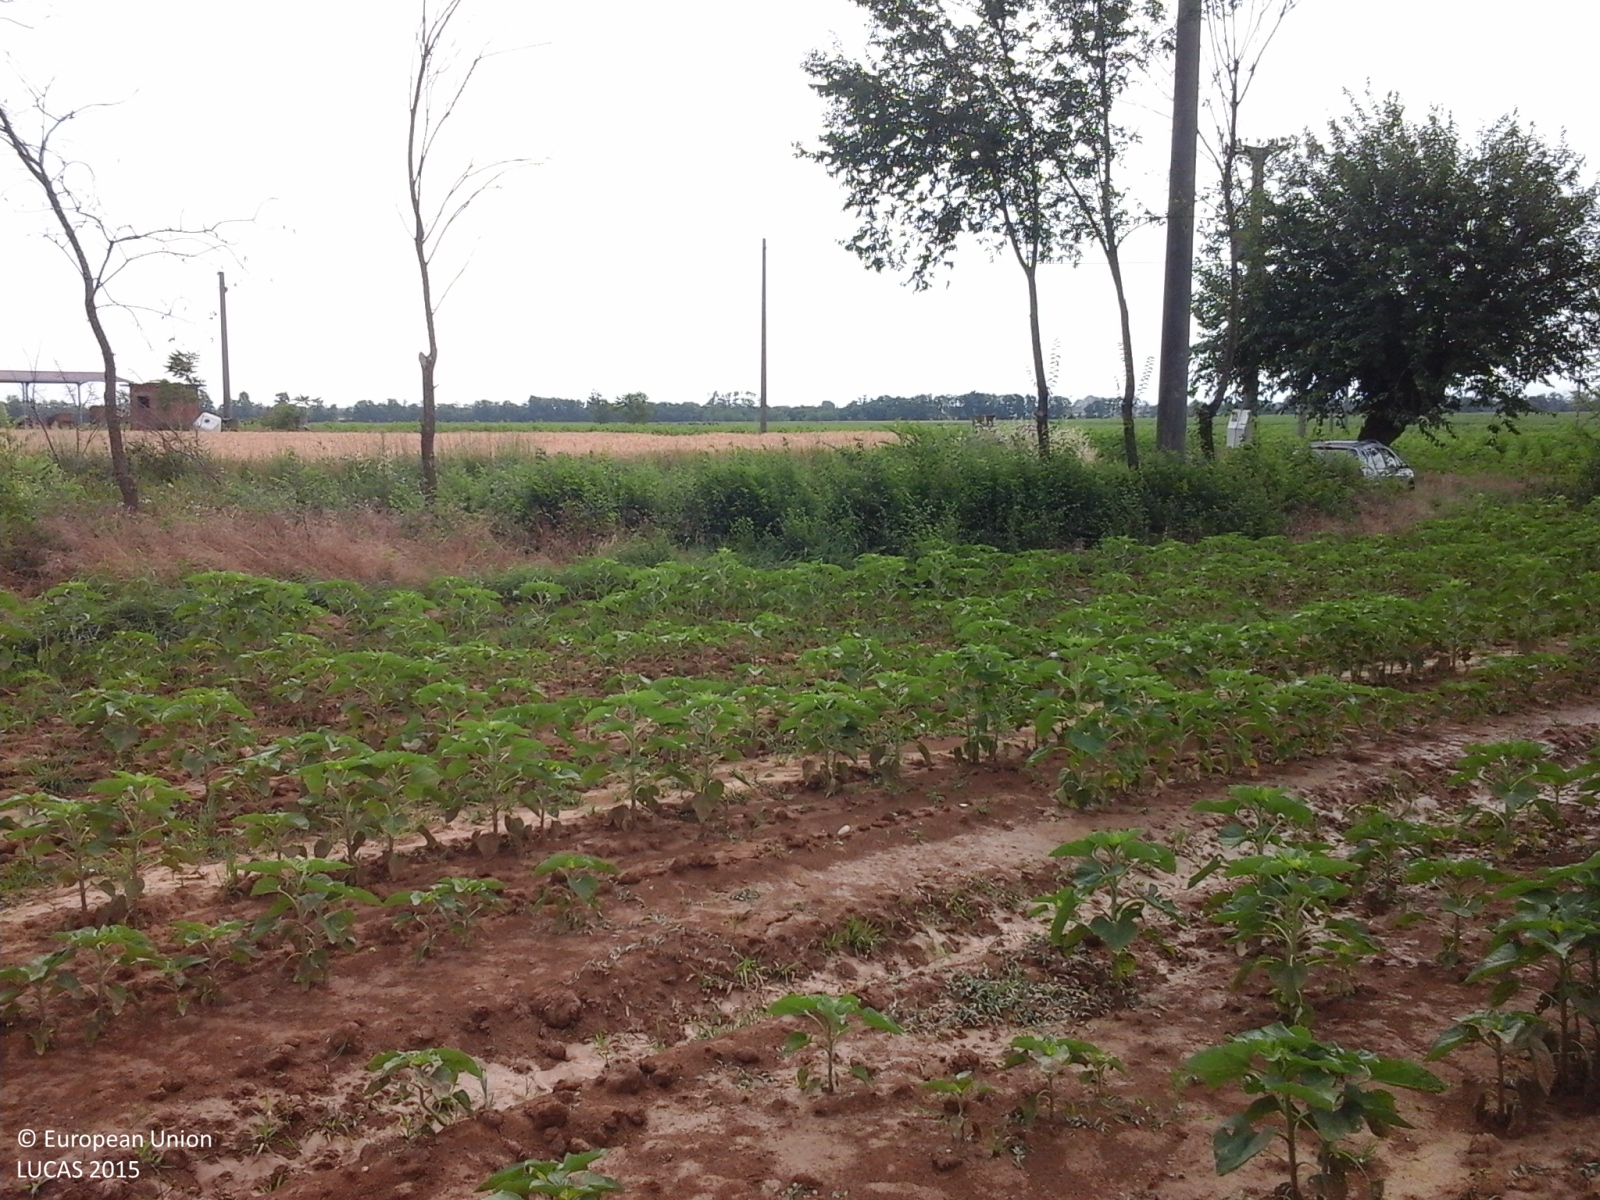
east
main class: Cropland
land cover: Sunflower
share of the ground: 50 - 75 %
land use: Agriculture (excluding fallow land and kitchen gardens)
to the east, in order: Sunflower; Managed hedges; Paved roads, cycling and walking lanes; Grass margins; Common wheat; Grass margins; Electric lines; Paved roads, cycling and walking lanes; Sunflower
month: June
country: IT
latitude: 44.8100
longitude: 8.5993
